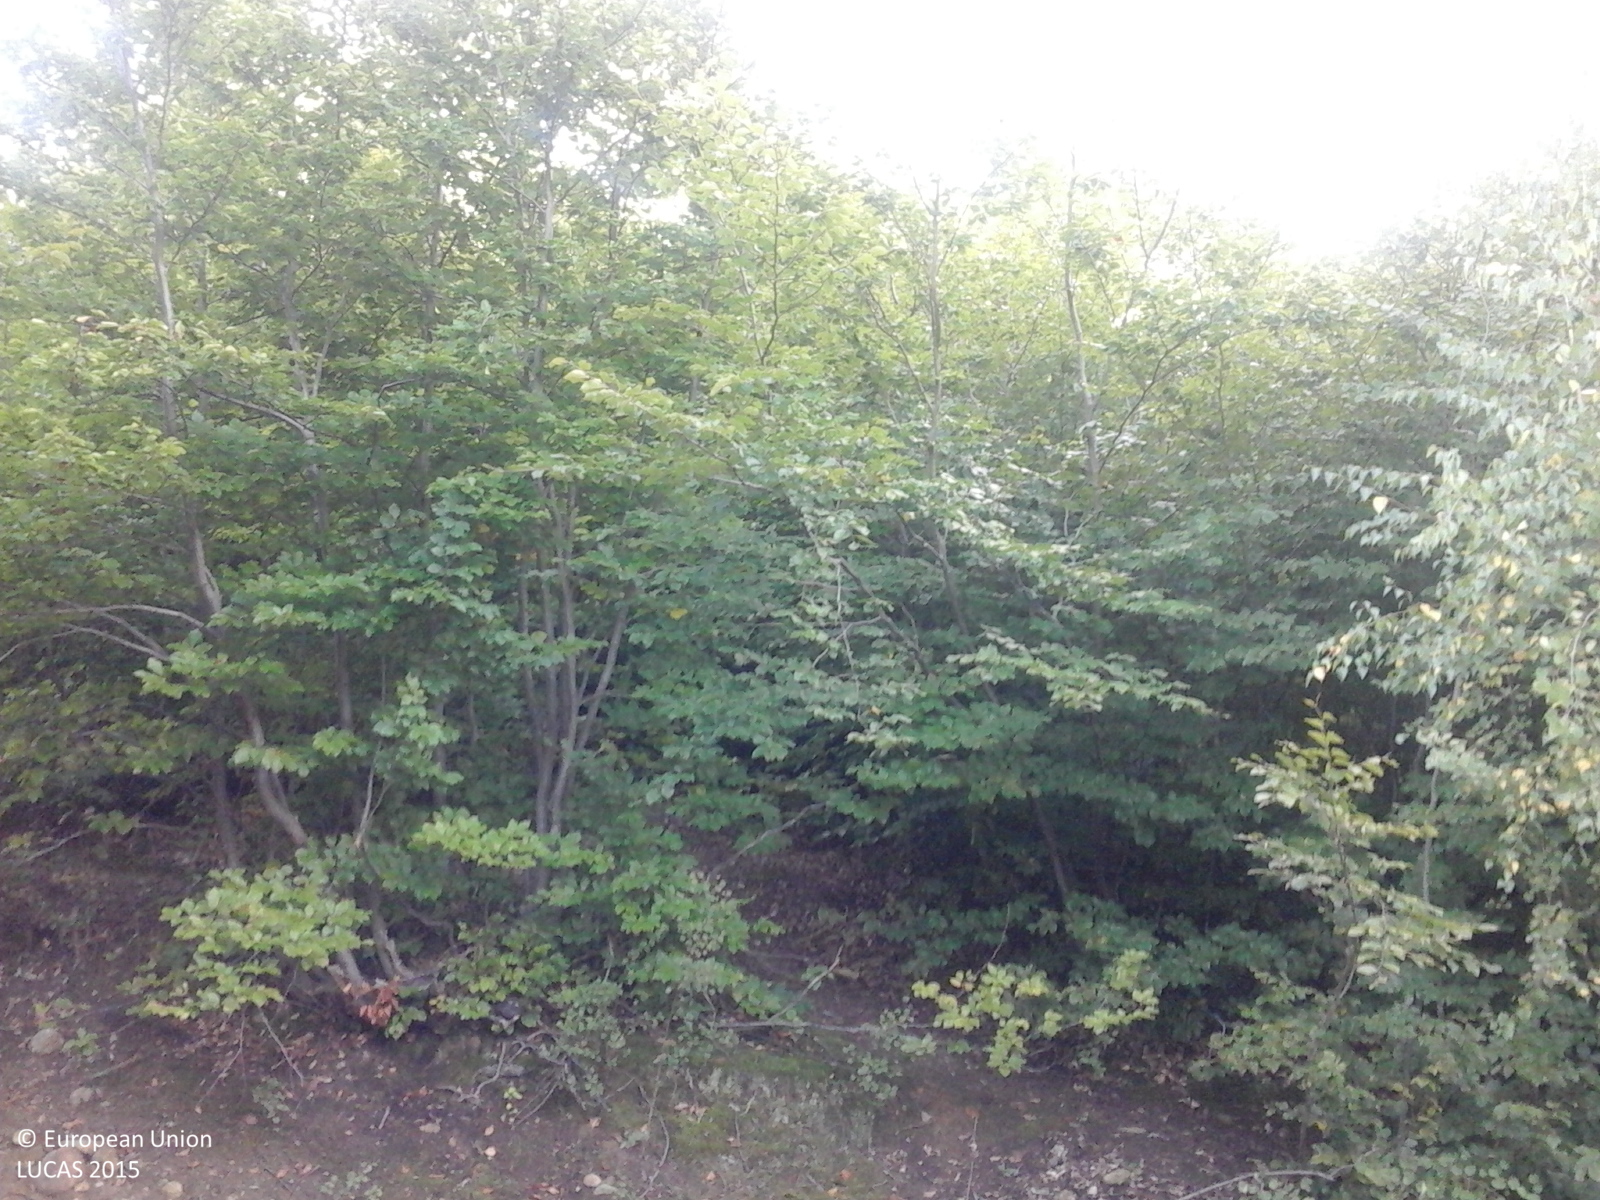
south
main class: Woodland
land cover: Broadleaved woodland
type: mesophytic deciduous forest
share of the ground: > 75 %
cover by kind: broadleaved forest trees 100 %
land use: Forestry
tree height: > 5 m
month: September
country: RO
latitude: 45.0566
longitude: 23.6087
